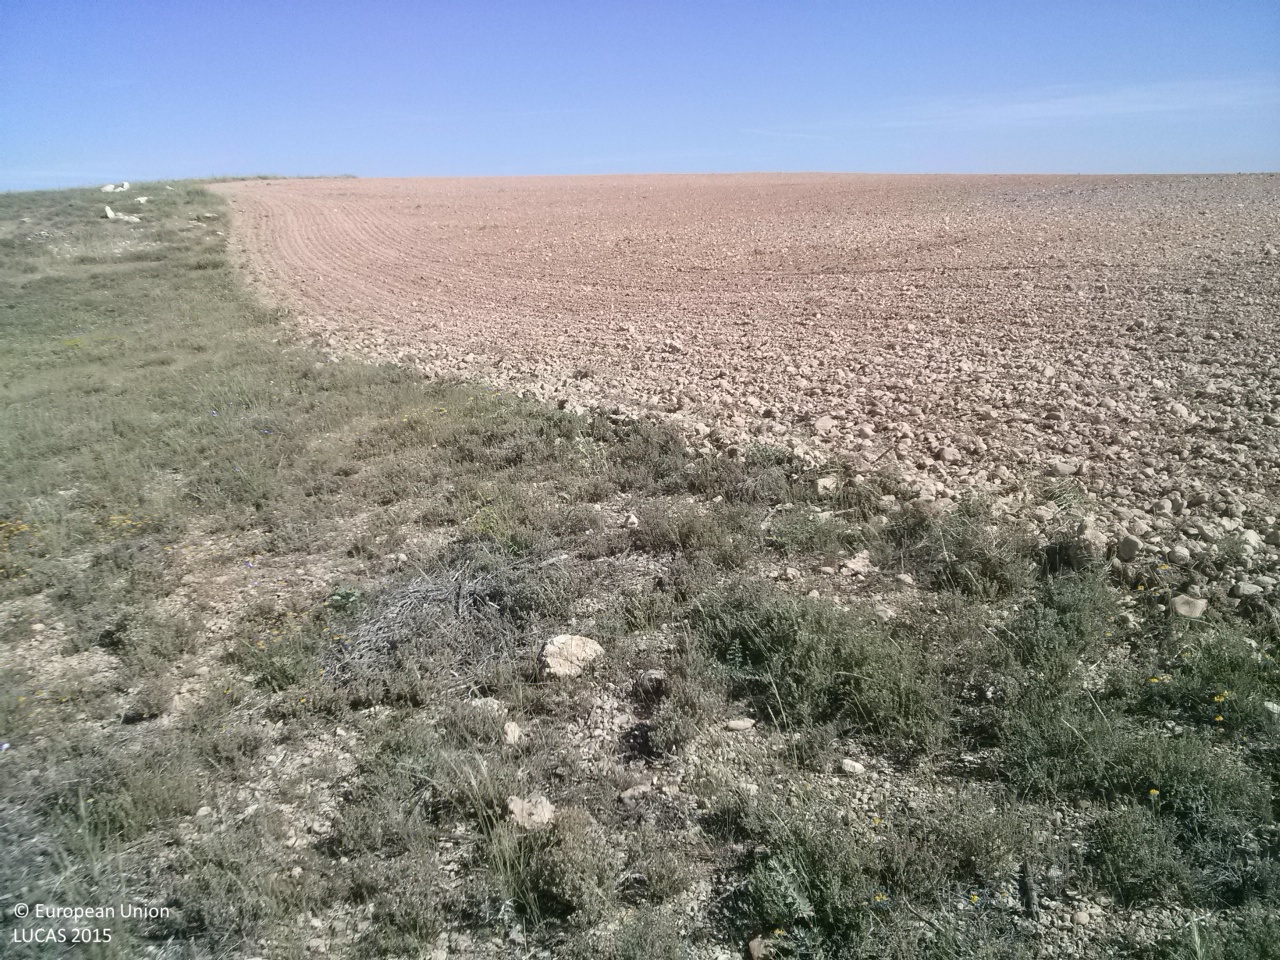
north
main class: Shrubland
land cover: Shrubland without tree cover
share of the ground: 50 - 75 %
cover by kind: shrubs 50 %, herbaceous plants 30 %, unconsolidated bare surface 20 %
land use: Semi-natural and natural areas not in use
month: May
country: ES
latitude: 39.9362
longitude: -2.6696
